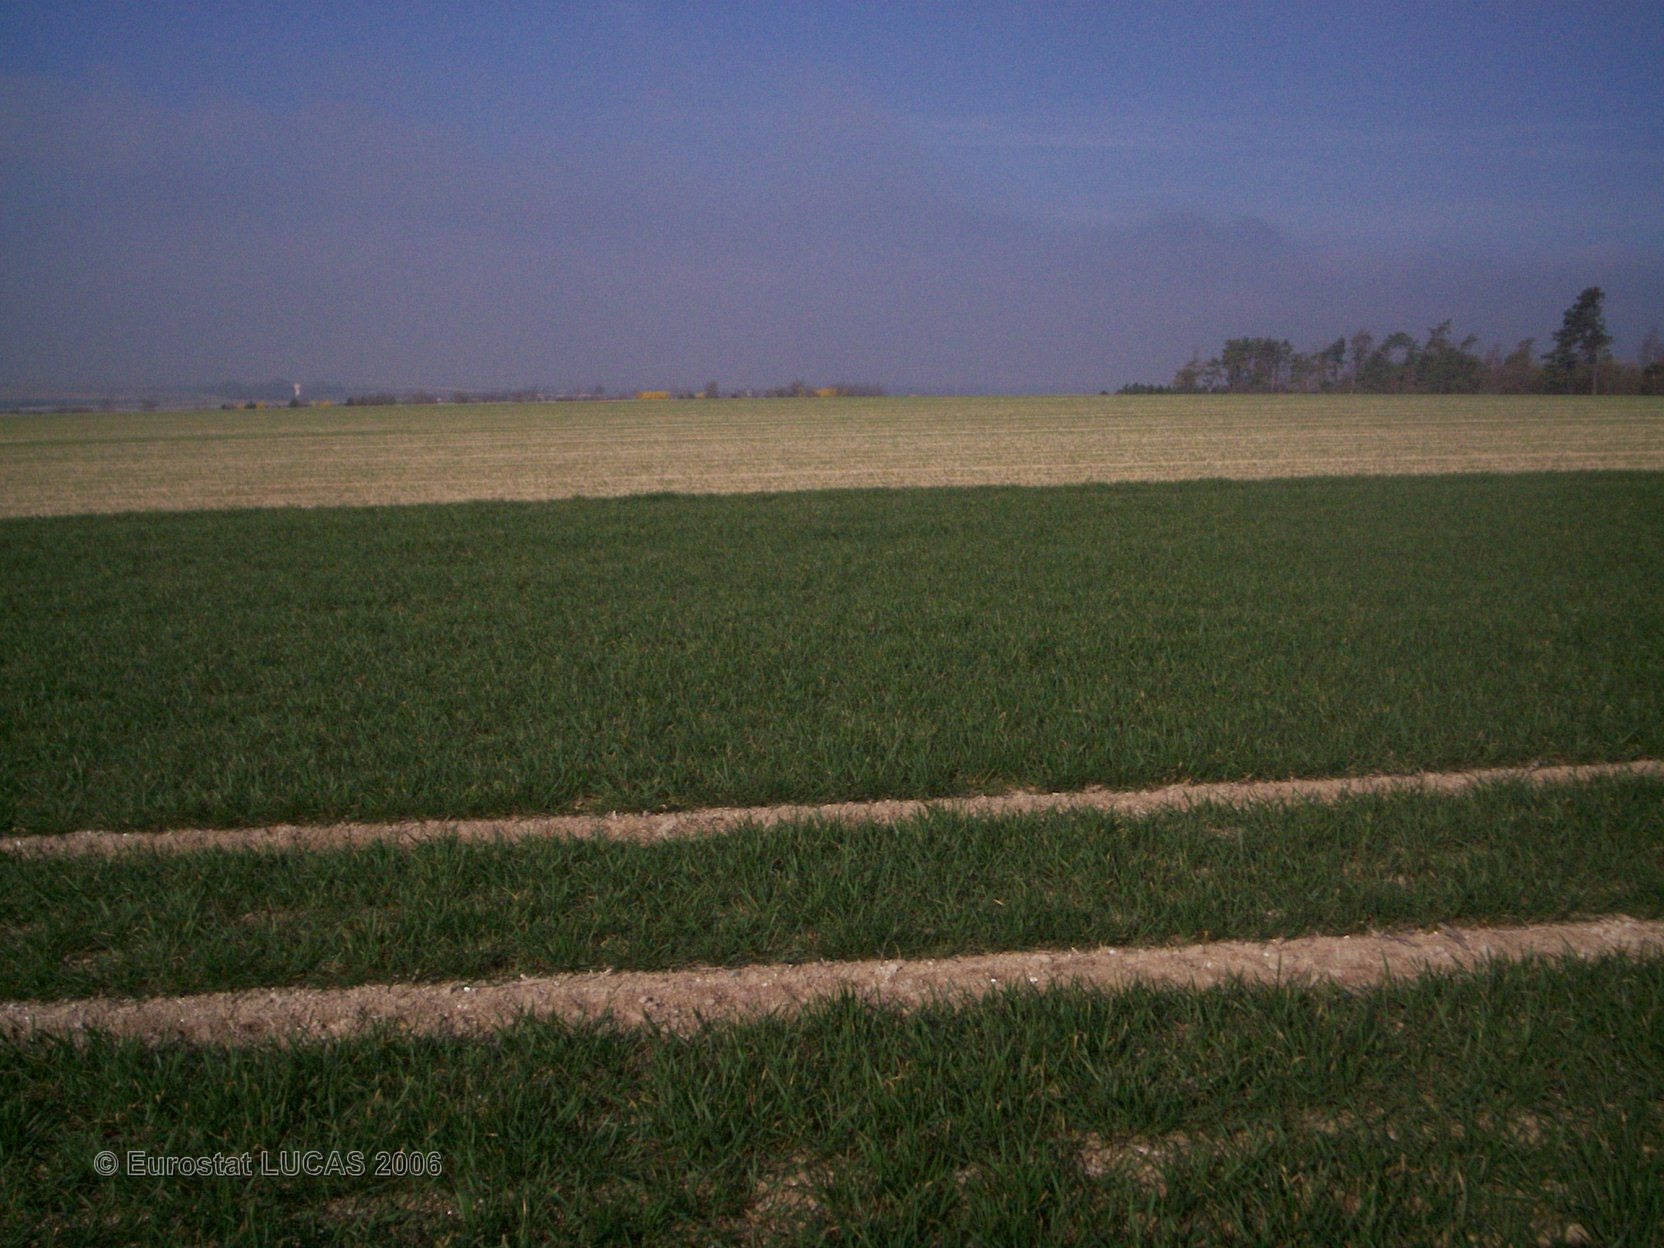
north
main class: Cropland
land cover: Barley
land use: Agriculture (excluding fallow land and kitchen gardens)
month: April
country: FR
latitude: 49.1196
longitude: 4.6121
